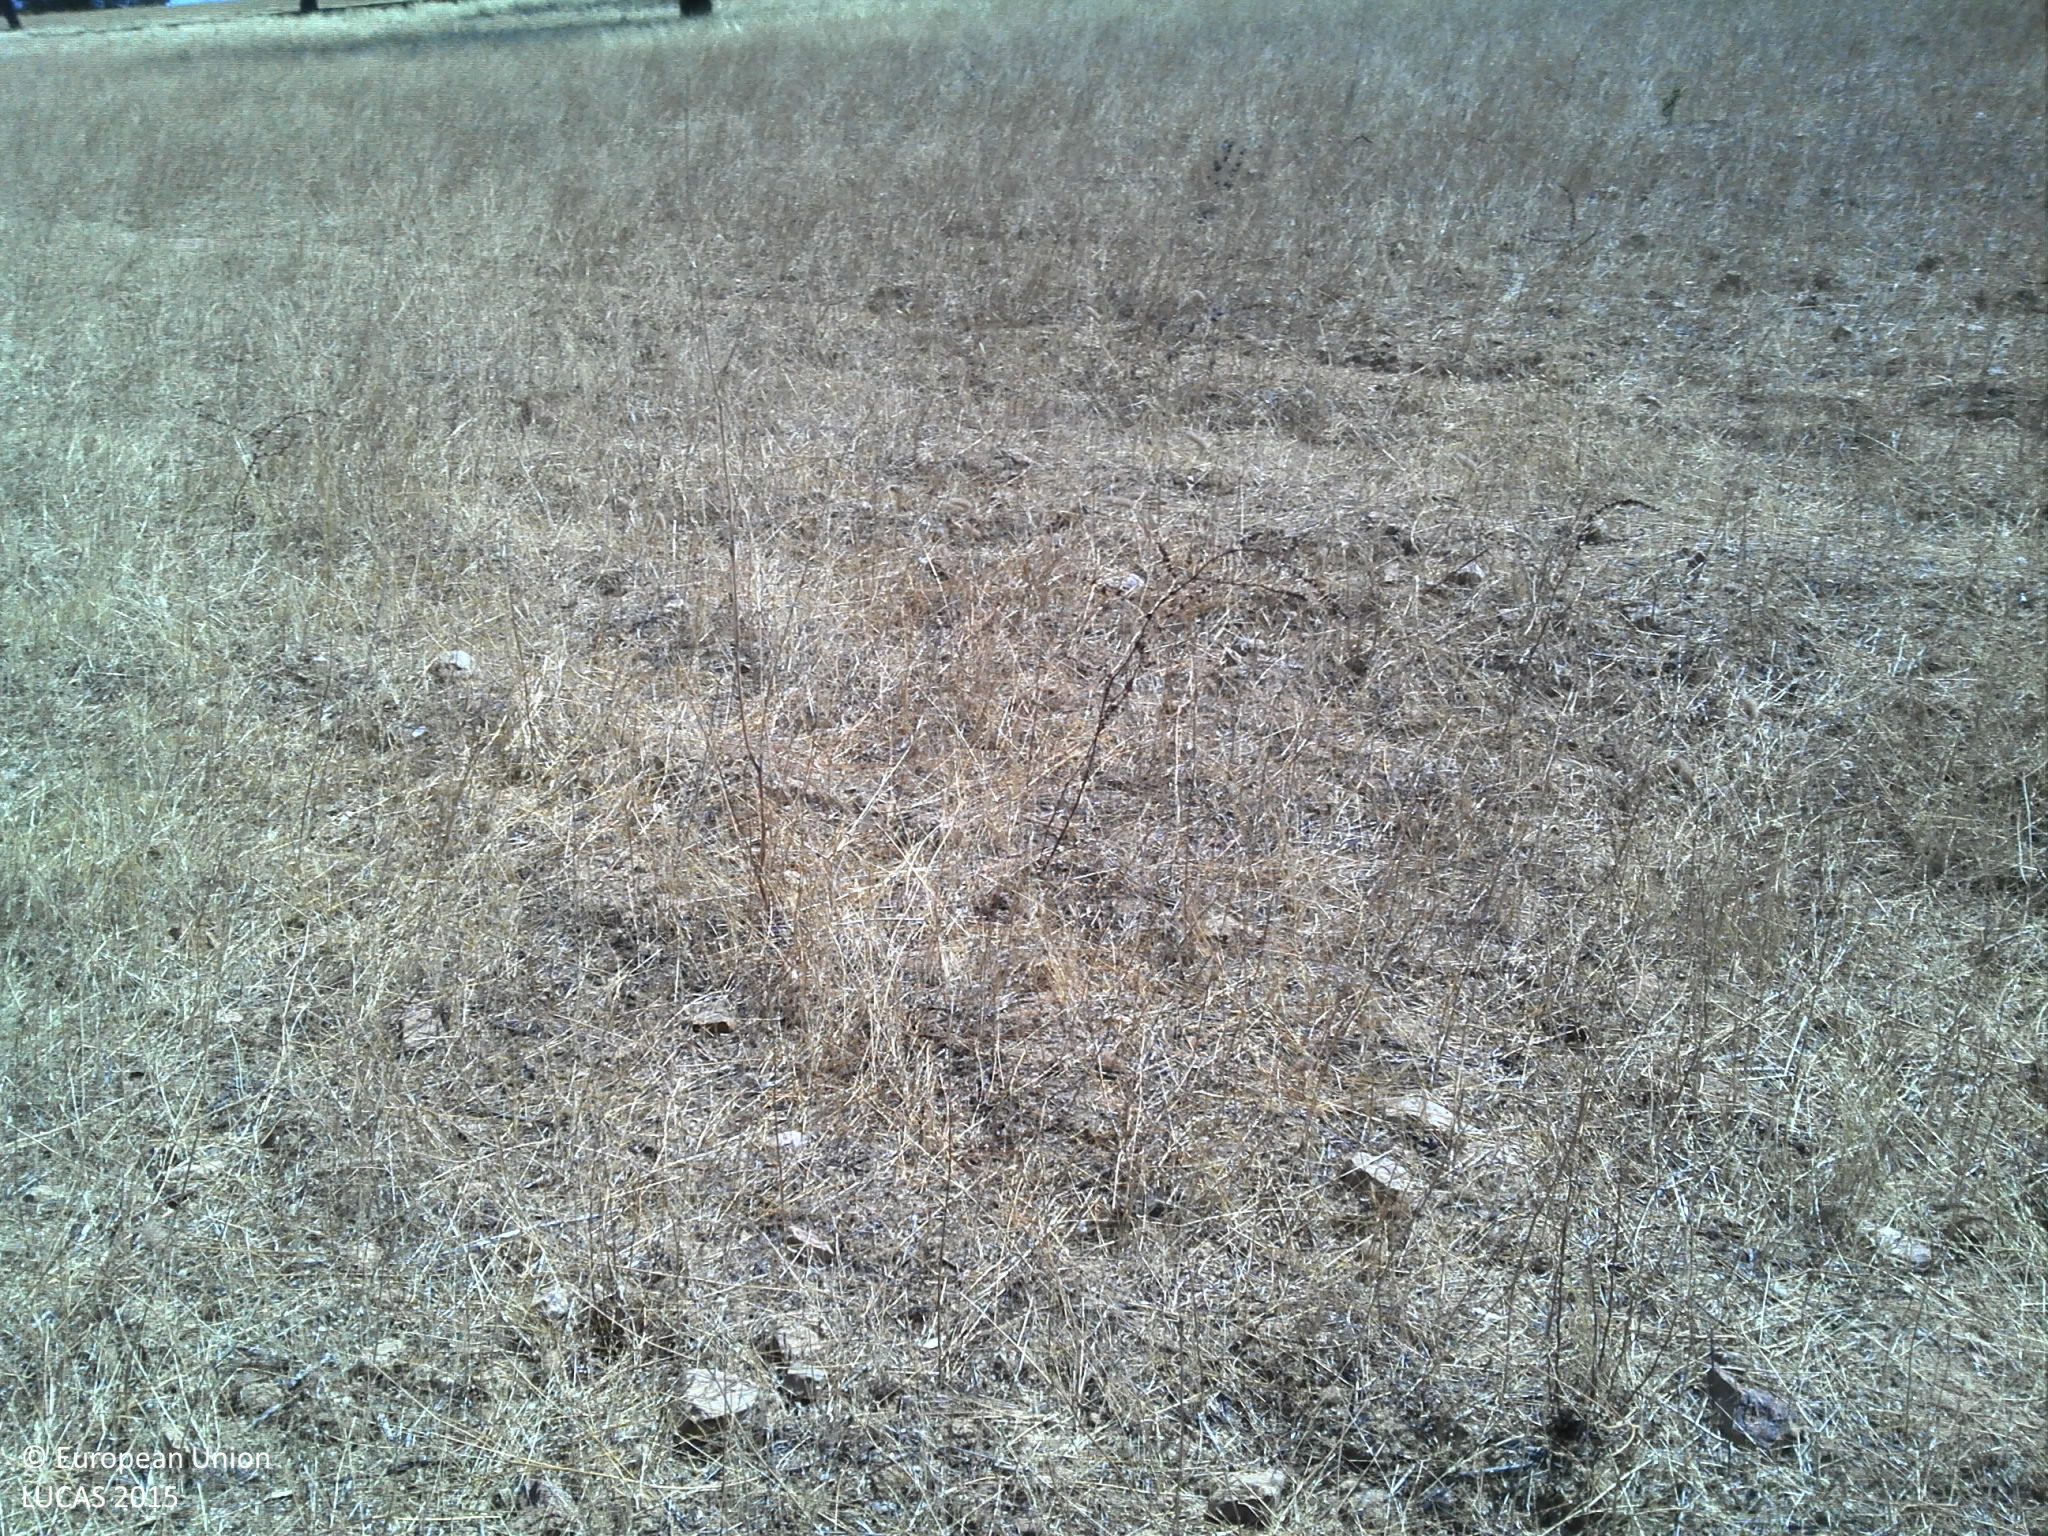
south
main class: Grassland
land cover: Grassland without tree/shrub cover
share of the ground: 10 - 25 %
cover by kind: unconsolidated bare surface 75 %, herbaceous plants 25 %
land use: Agriculture (excluding fallow land and kitchen gardens)
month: July
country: PT
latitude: 37.7863
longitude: -7.9316
